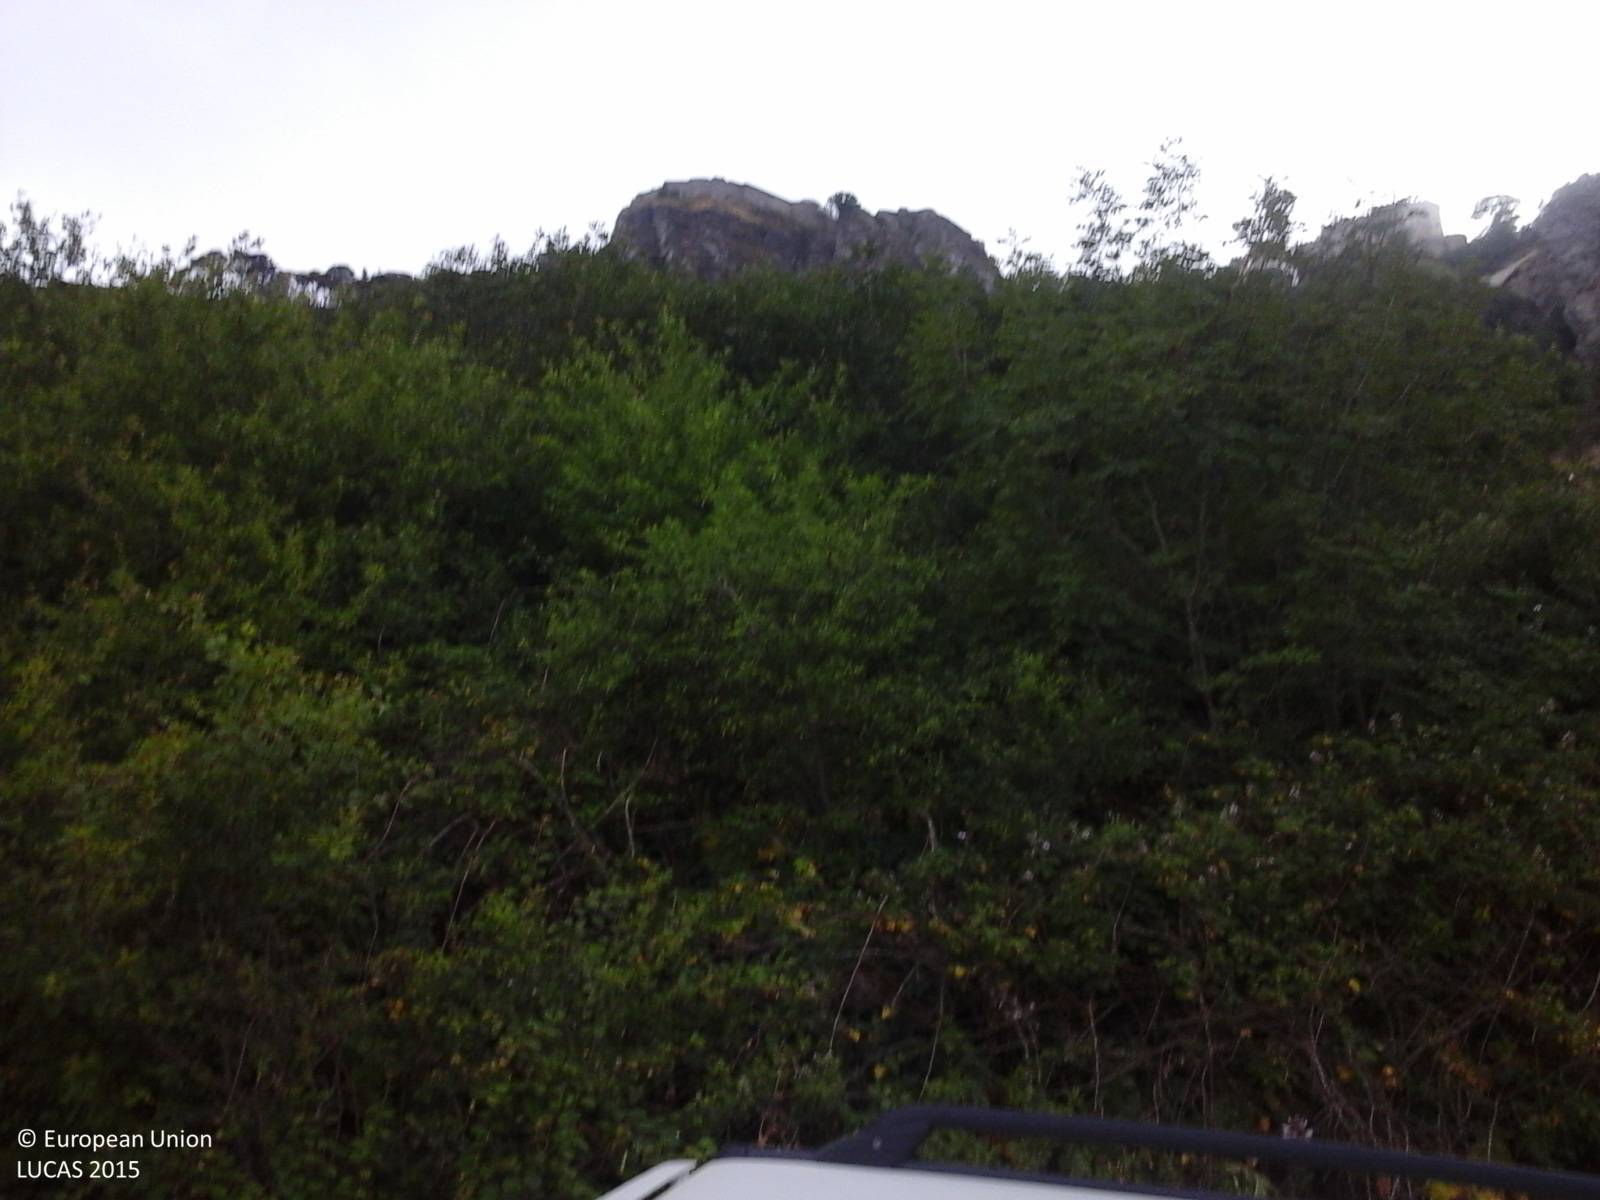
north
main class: Shrubland
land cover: Shrubland with sparse tree cover
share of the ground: > 75 %
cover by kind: herbaceous plants 85 %, shrubs 10 %, broadleaved forest trees 5 %
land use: Semi-natural and natural areas not in use
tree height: < 5 m
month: June
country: IT
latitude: 38.0391
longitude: 12.5905
